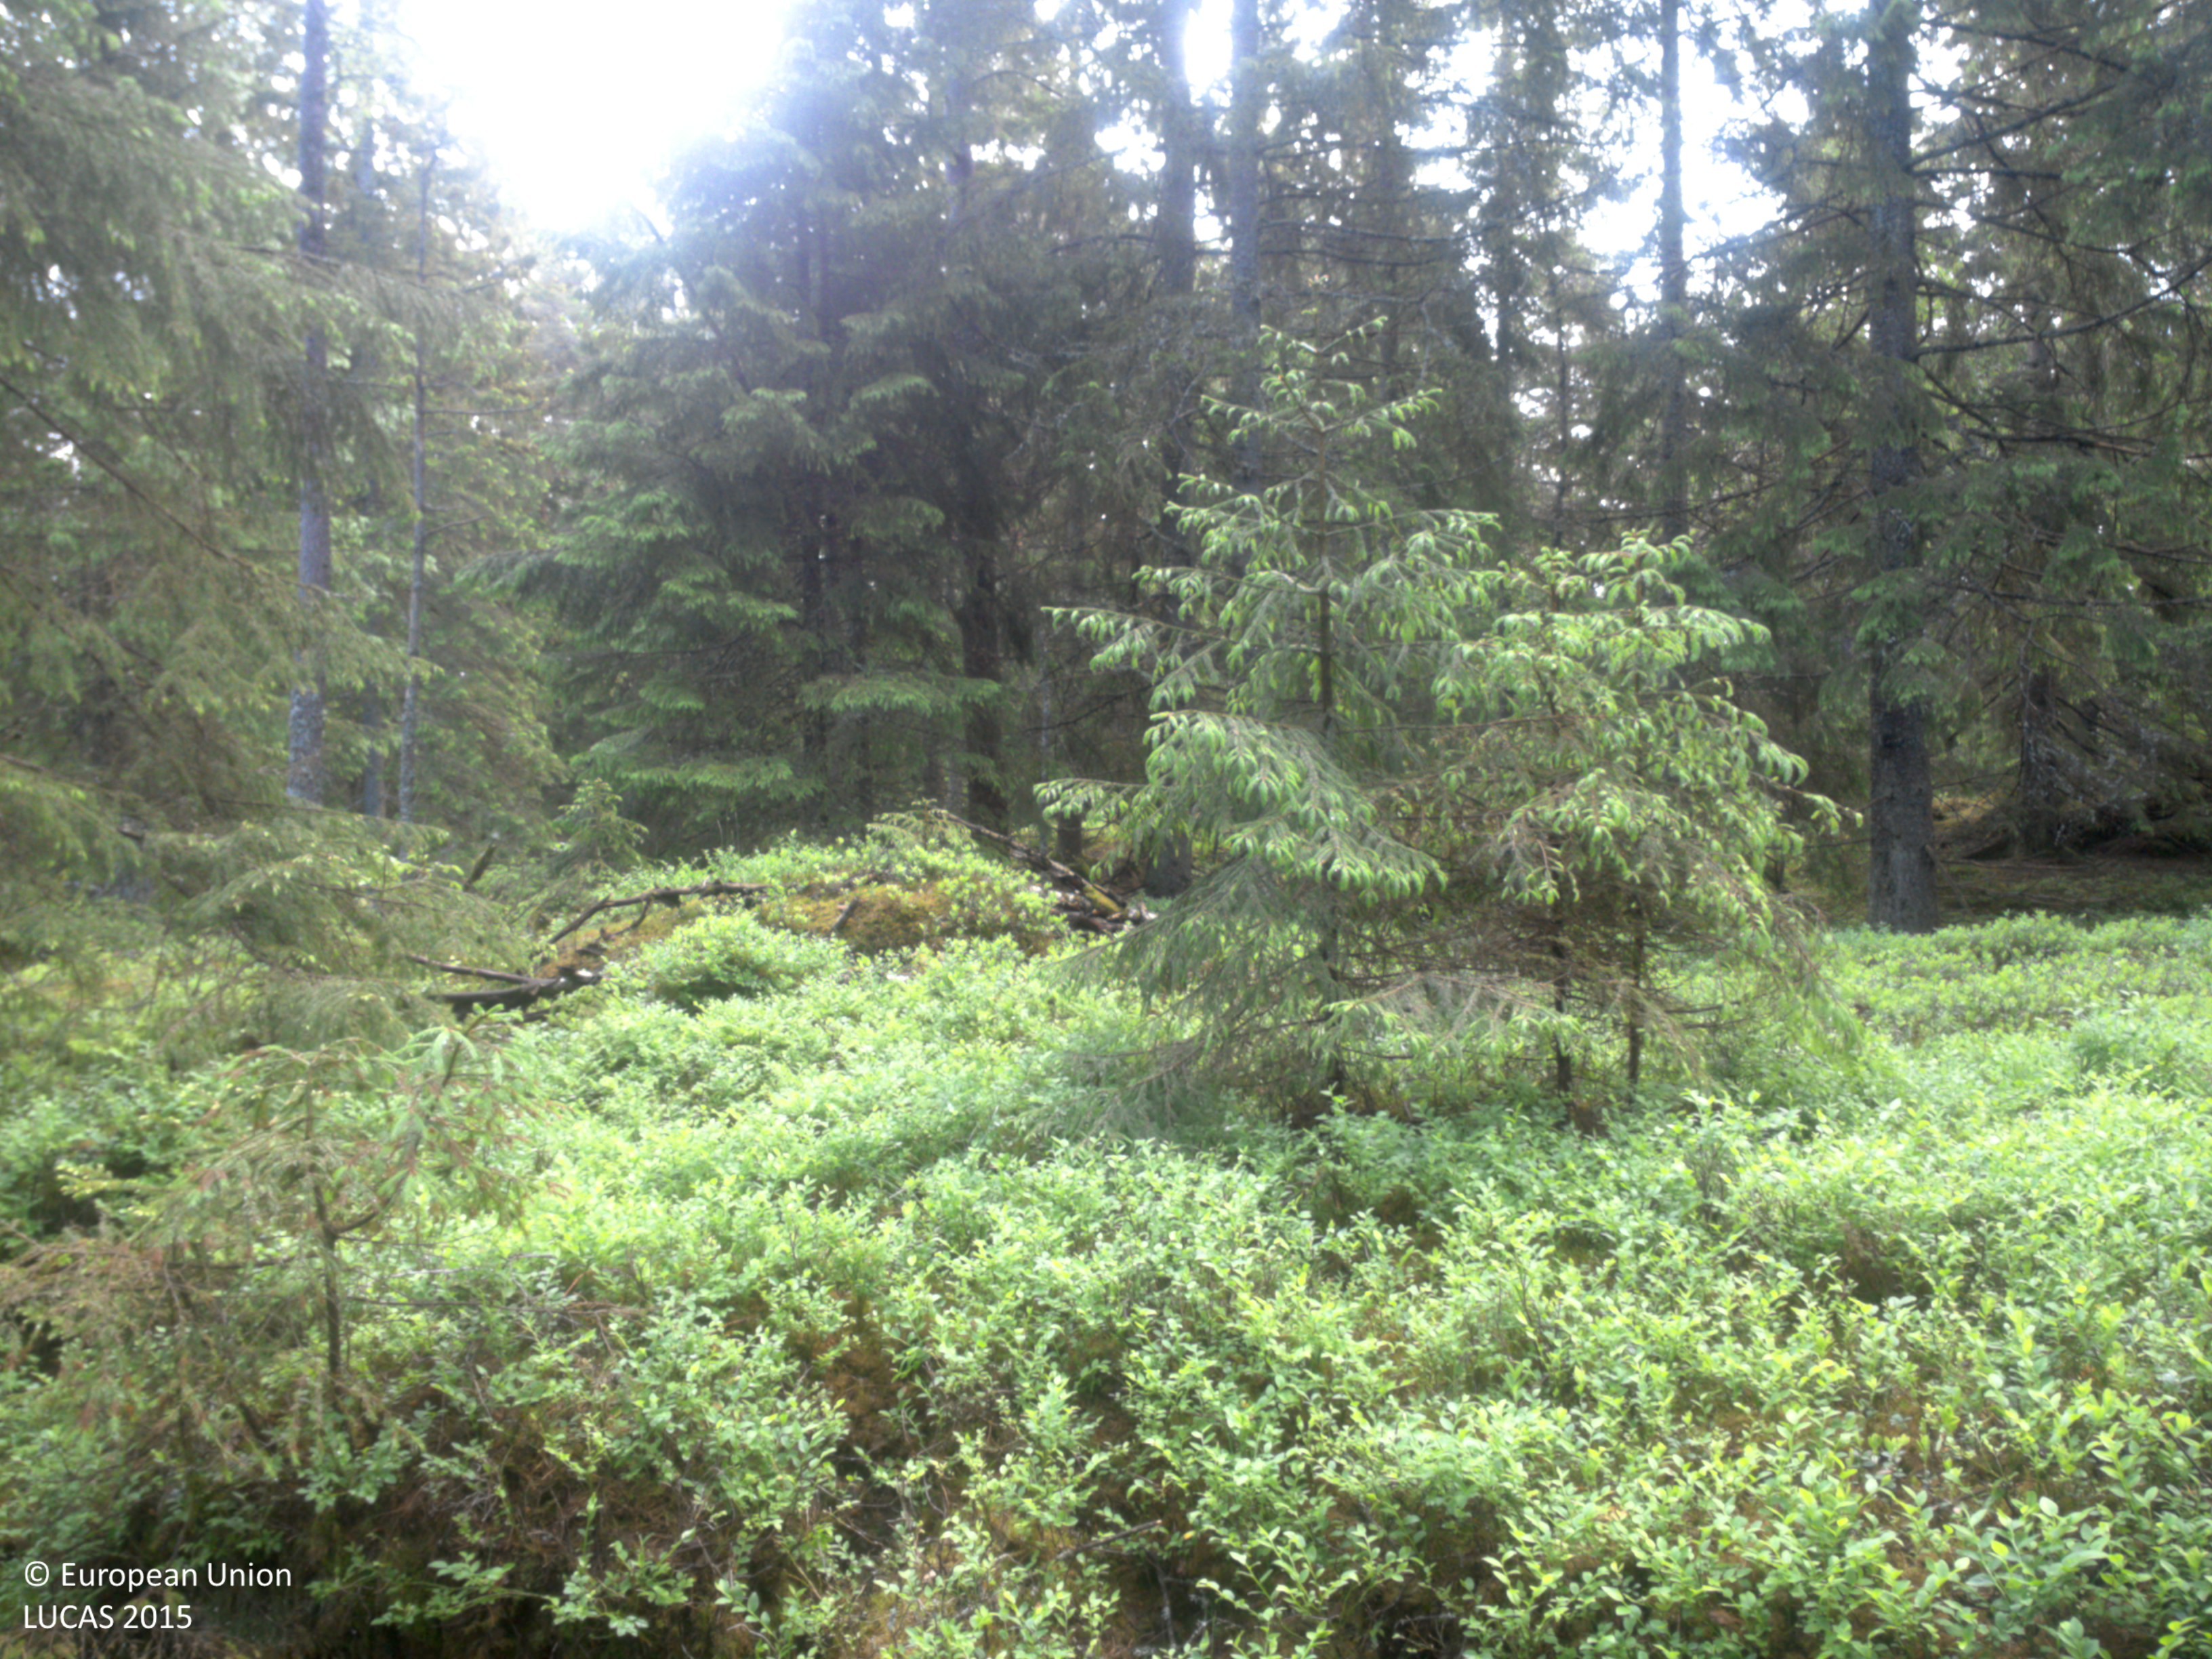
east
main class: Woodland
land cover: Spruce dominated coniferous woodland
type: boreal forest
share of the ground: 50 - 75 %
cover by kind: coniferous forest trees 50 %, lichens and mosses 30 %, shrubs 20 %
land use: Forestry
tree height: > 5 m
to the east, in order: Spruce dominated coniferous woodland; Tracks; Spruce dominated coniferous woodland; Rock outcrops; Spruce dominated coniferous woodland; Rock outcrops; Spruce dominated coniferous woodland; Tracks; Spruce dominated coniferous woodland; Rock outcrops; Spruce dominated coniferous woodland
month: June
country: SE
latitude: 58.4054
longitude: 11.7932
